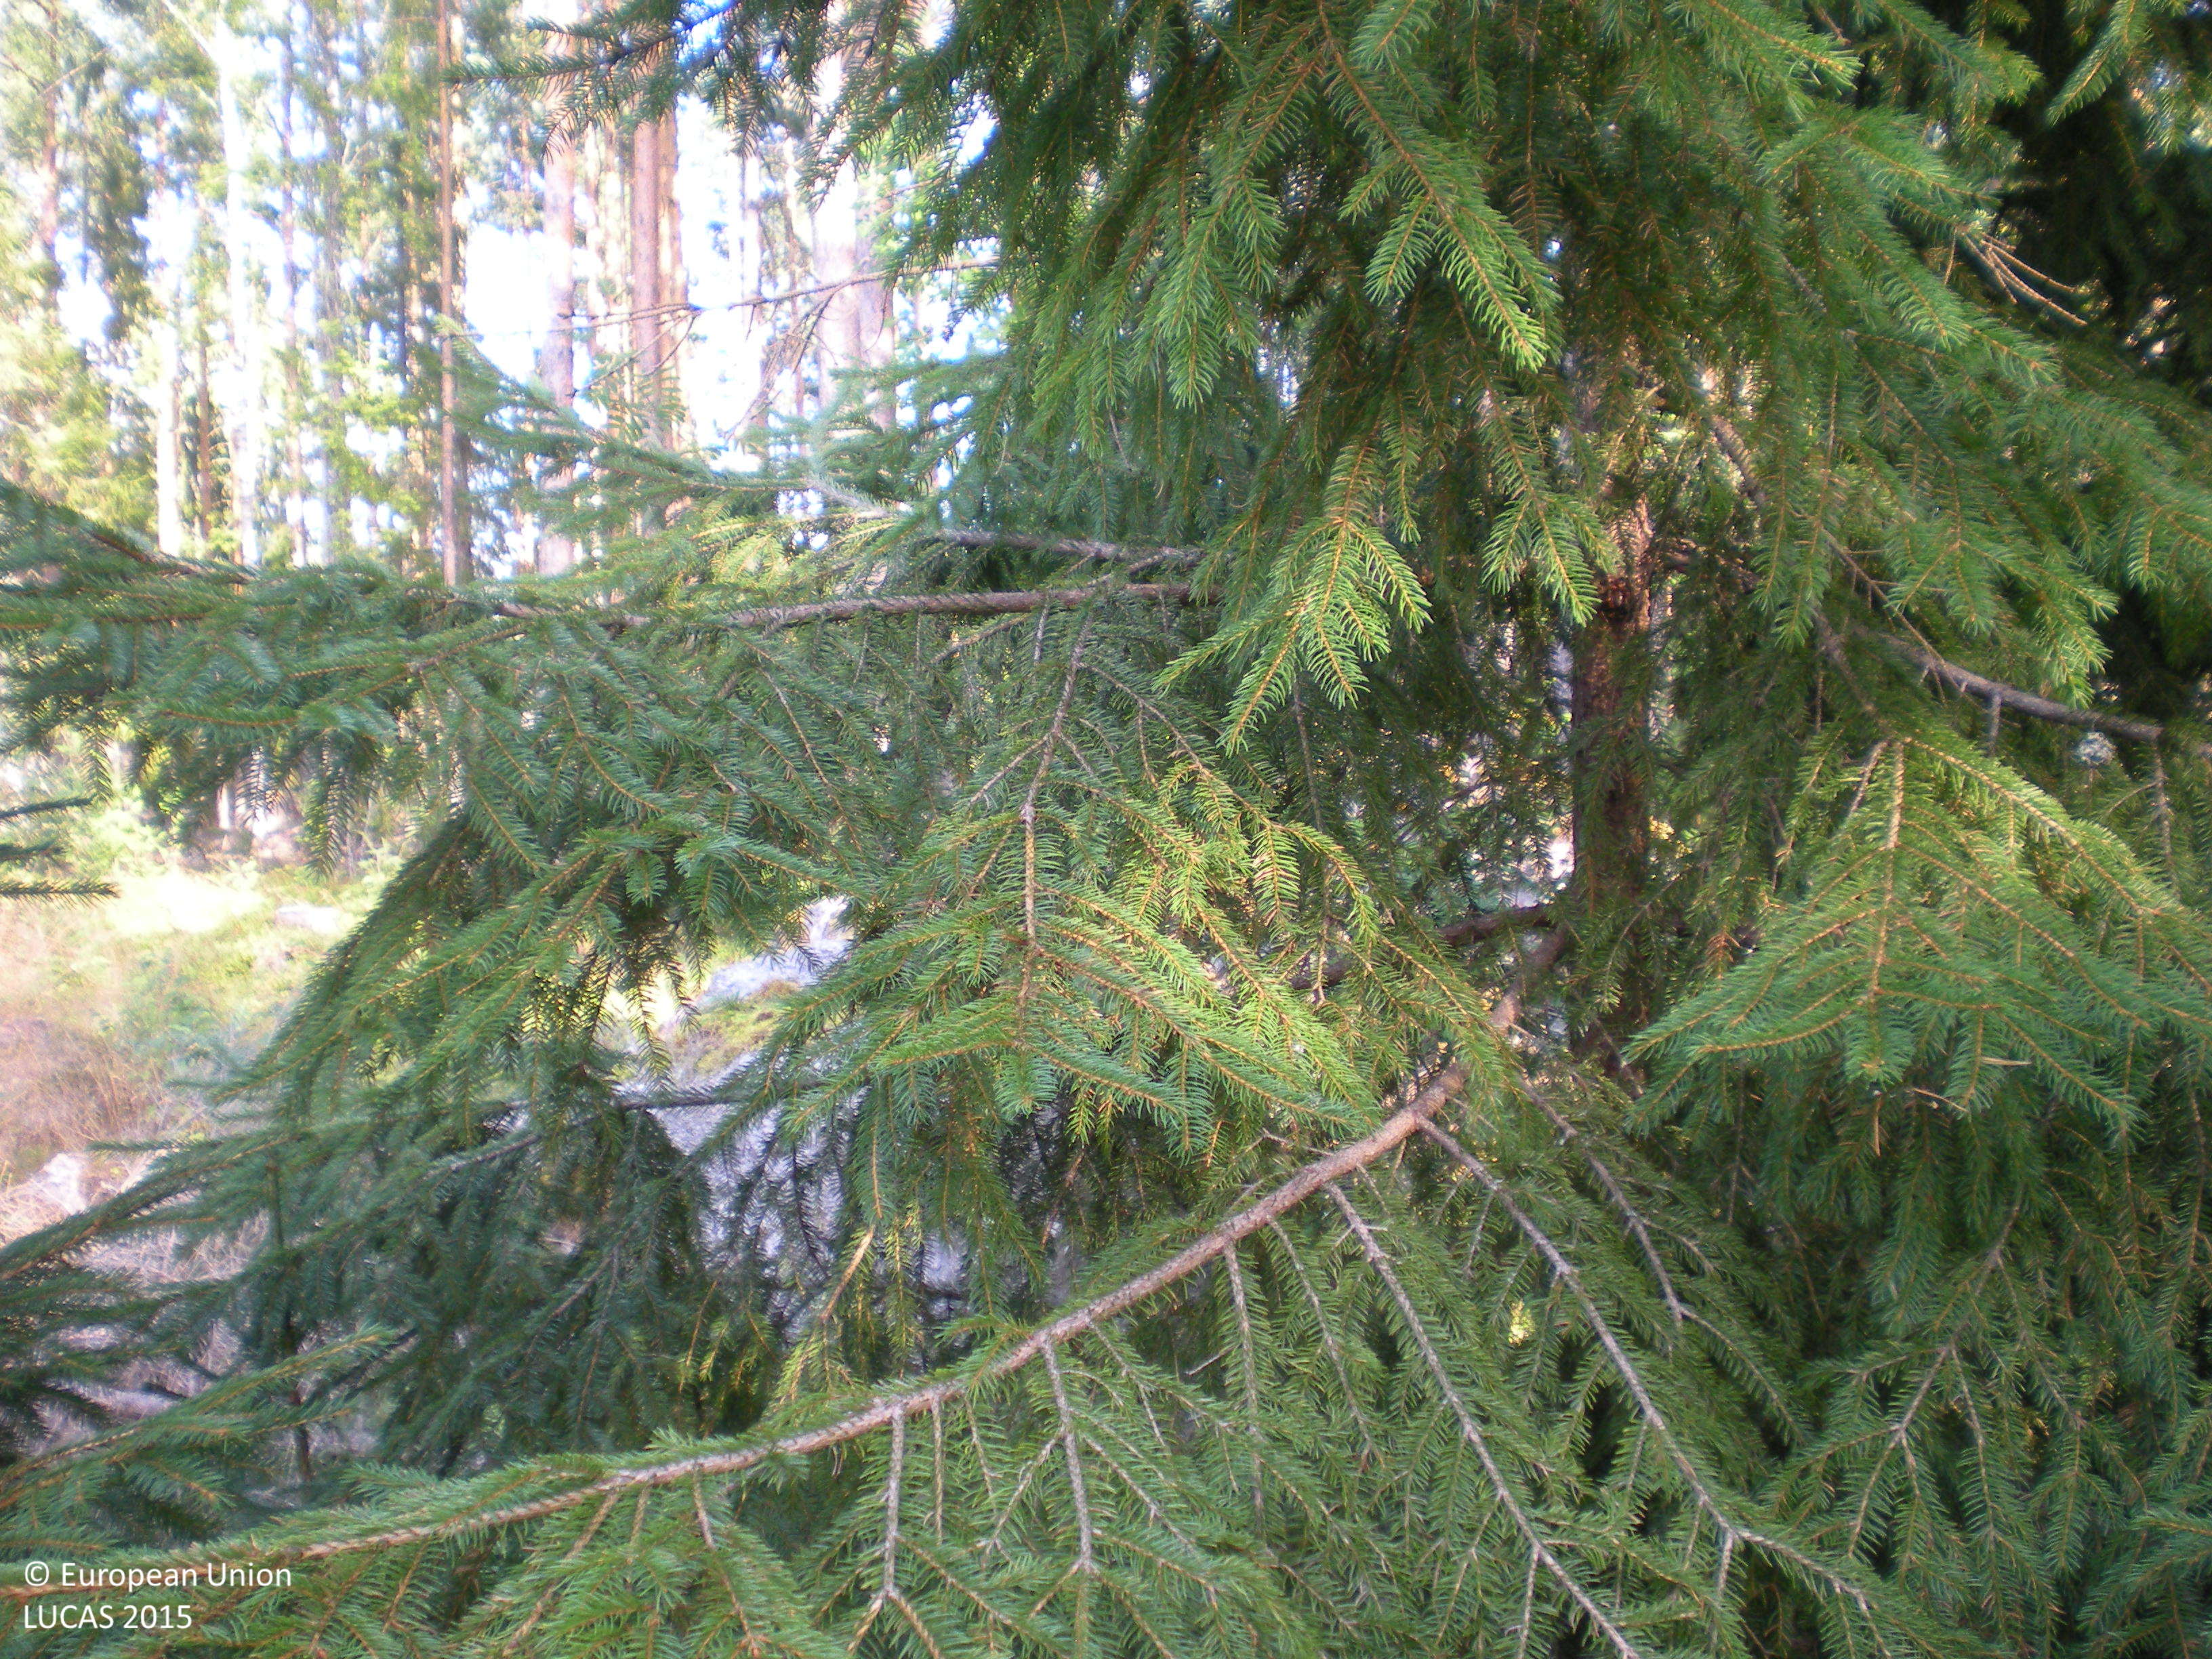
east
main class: Woodland
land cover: Spruce dominated coniferous woodland
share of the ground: 50 - 75 %
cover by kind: coniferous forest trees 50 %, shrubs 20 %, broadleaved forest trees 10 %, lichens and mosses 10 %, herbaceous plants 5 %, consolidated bare surface 5 %
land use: Forestry
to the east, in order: Spruce dominated coniferous woodland; Pine dominated coniferous woodland; Other coniferous woodland; Ditches and canals; Grassland without tree/shrub cover; Ditches and canals; Grassland without tree/shrub cover; Ditches and canals; Grassland without tree/shrub cover; Pine dominated coniferous woodland
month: August
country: SE
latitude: 60.3842
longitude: 17.0469
